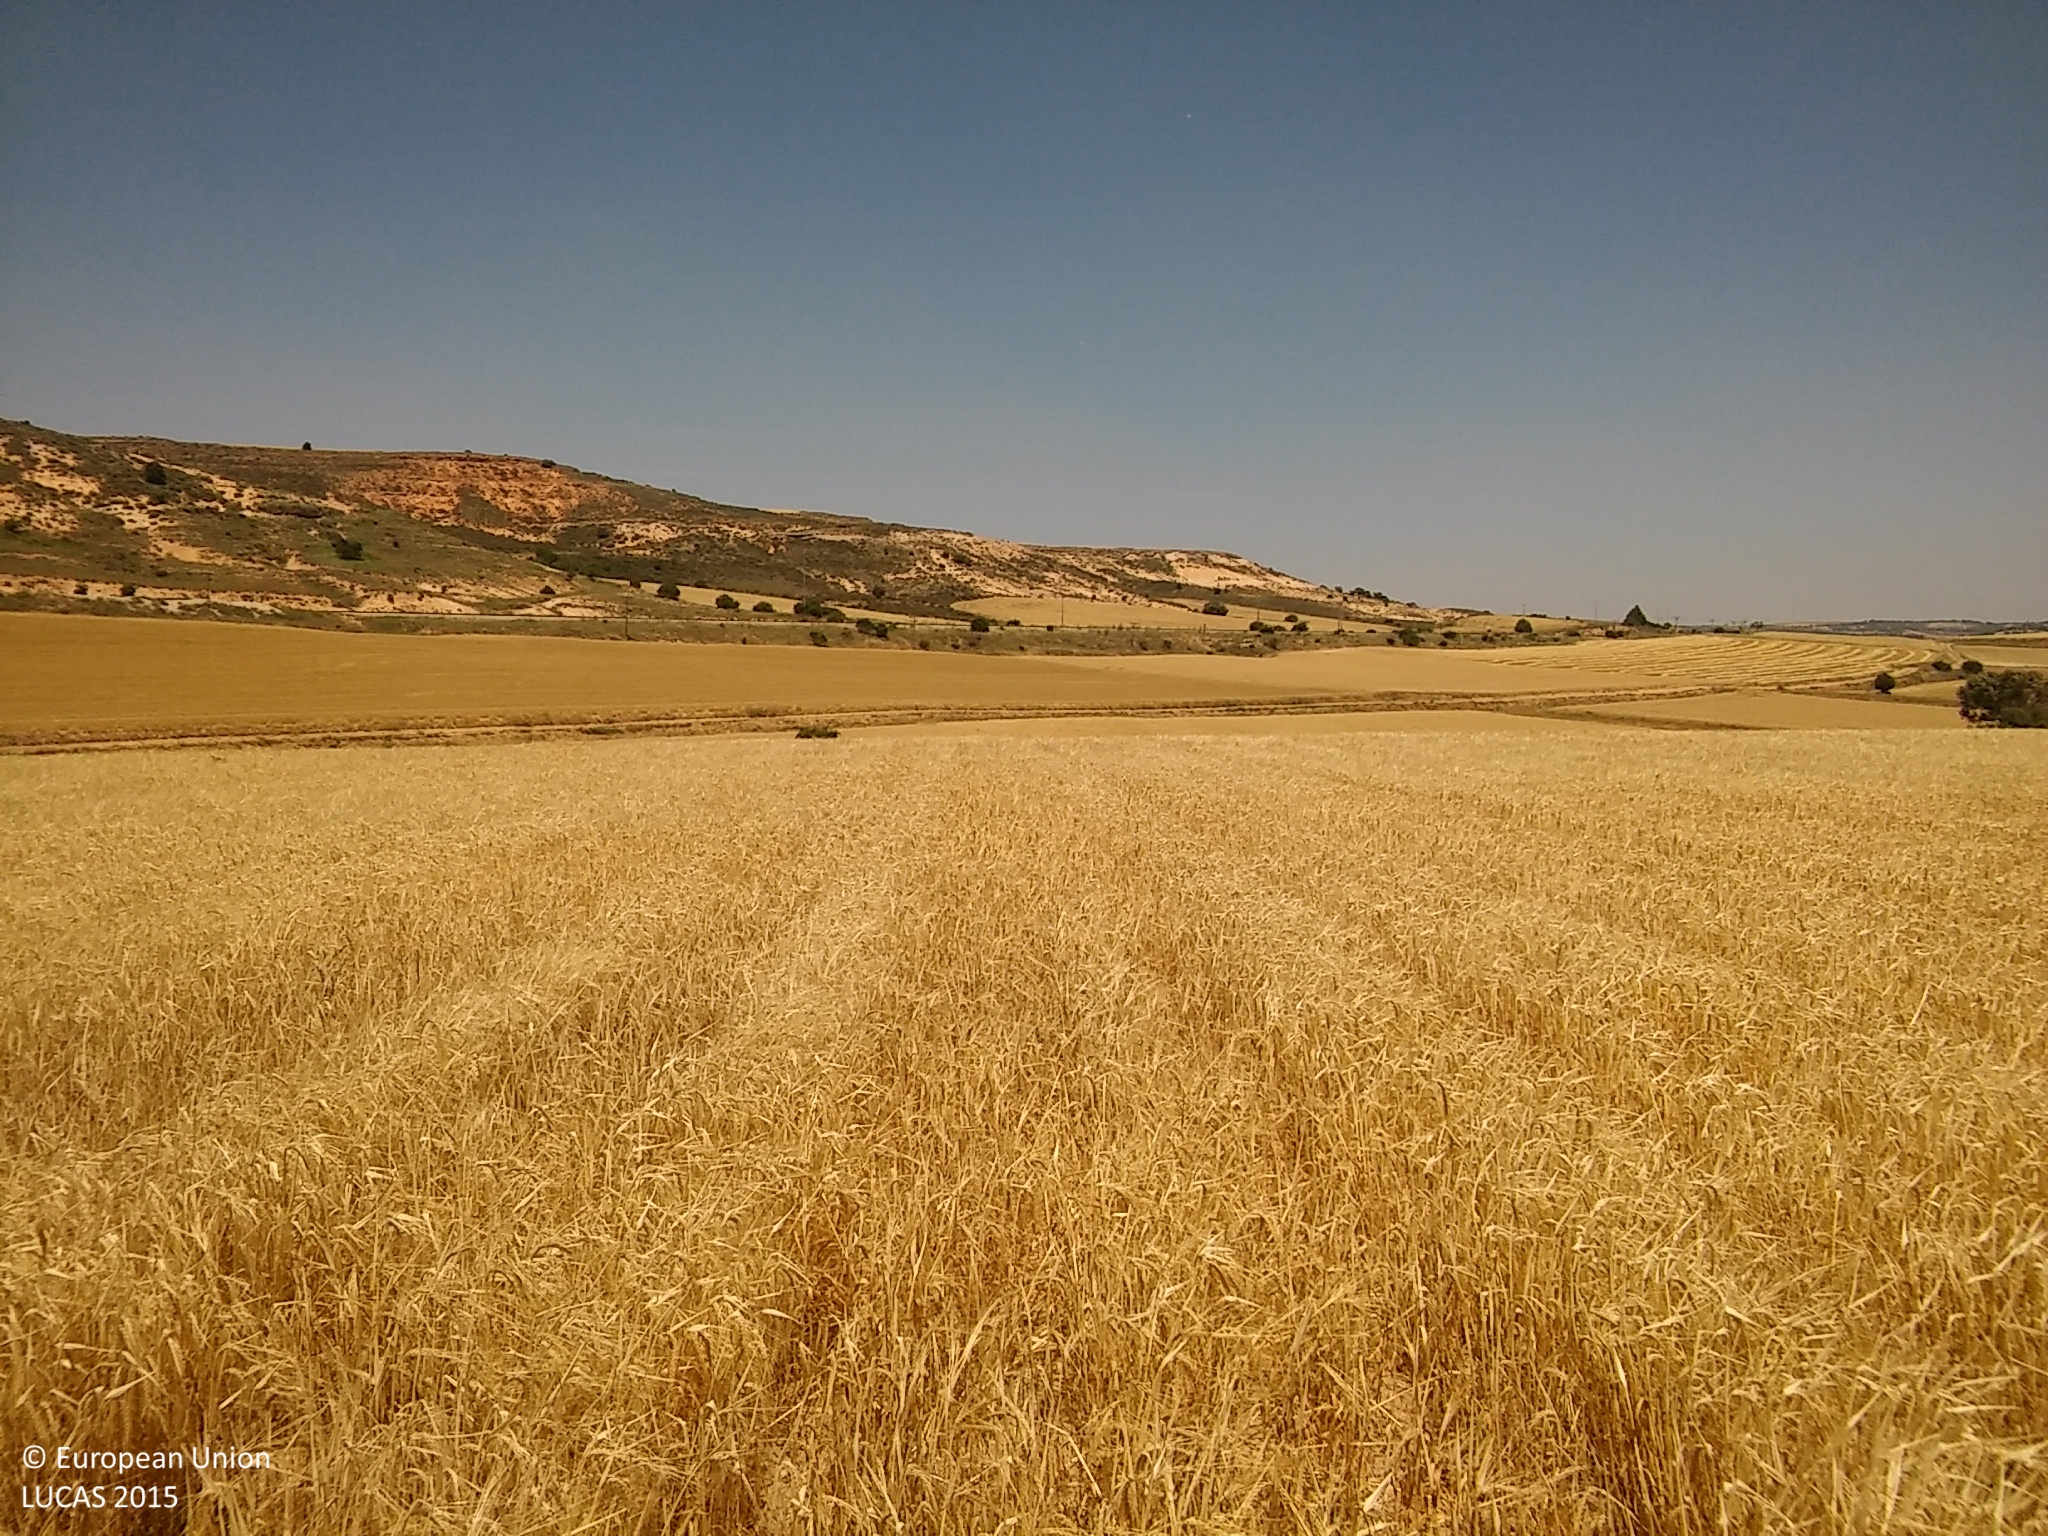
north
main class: Cropland
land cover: Barley
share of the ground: > 75 %
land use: Agriculture (excluding fallow land and kitchen gardens)
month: July
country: ES
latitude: 41.4833
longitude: -3.5459
